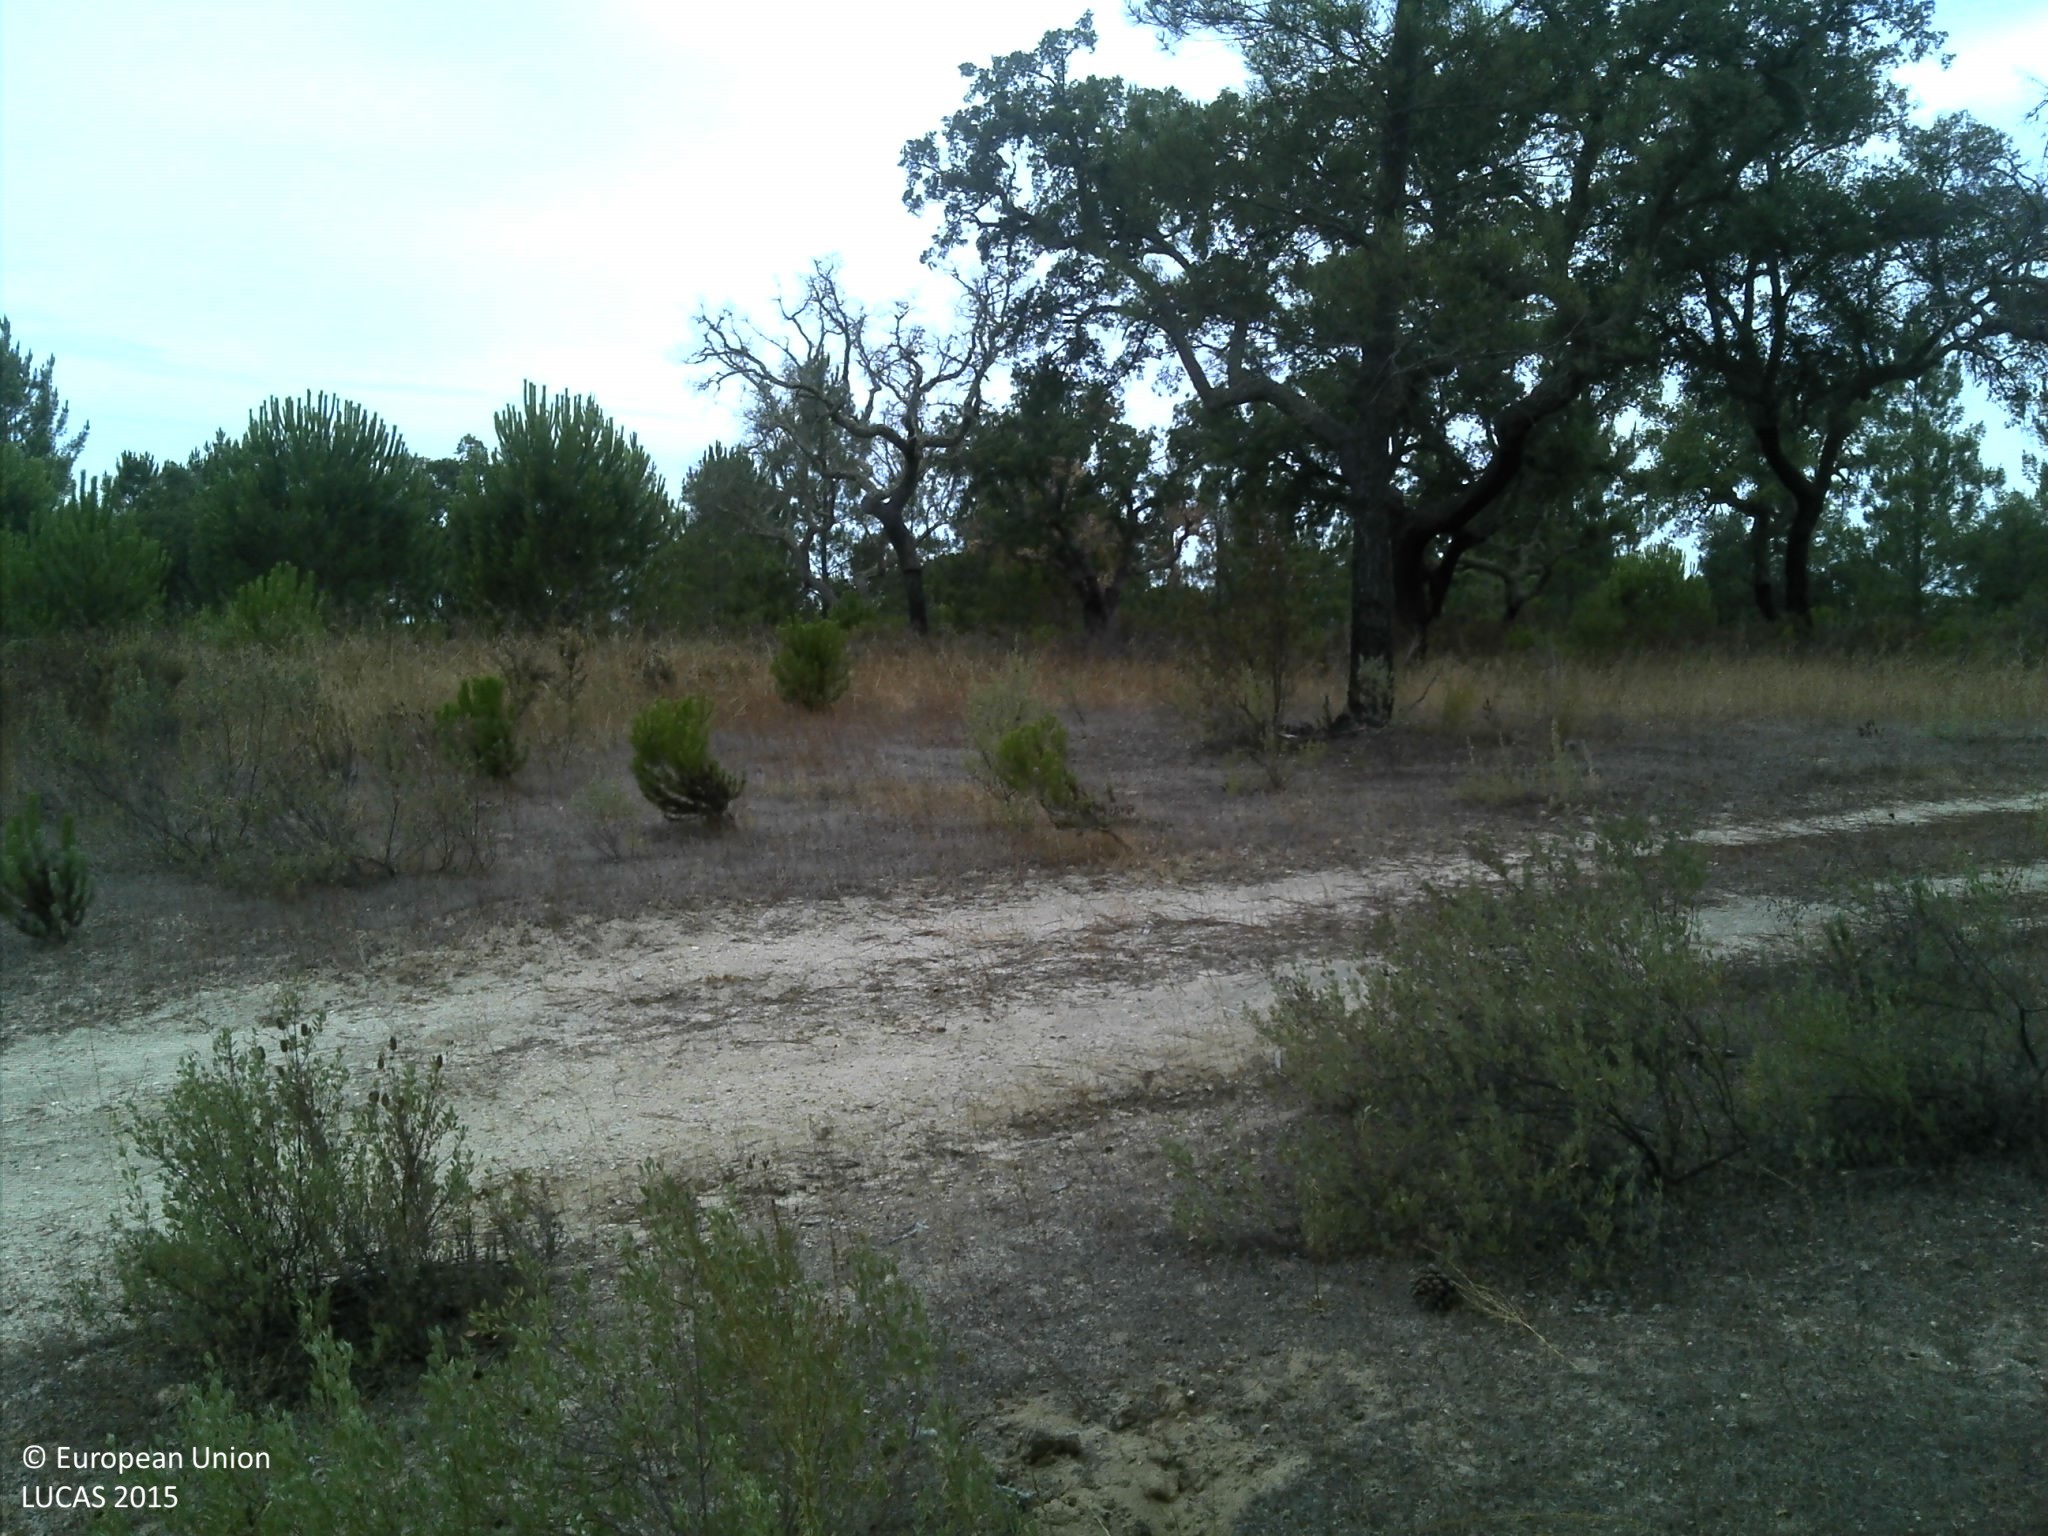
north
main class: Woodland
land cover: Pine dominated coniferous woodland
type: coniferous forest of the mediterranean region
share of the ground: 25 - 50 %
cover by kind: coniferous forest trees 45 %, shrubs 25 %, unconsolidated bare surface 20 %, herbaceous plants 10 %
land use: Forestry
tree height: > 5 m
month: August
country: PT
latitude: 38.9284
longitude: -8.2456
